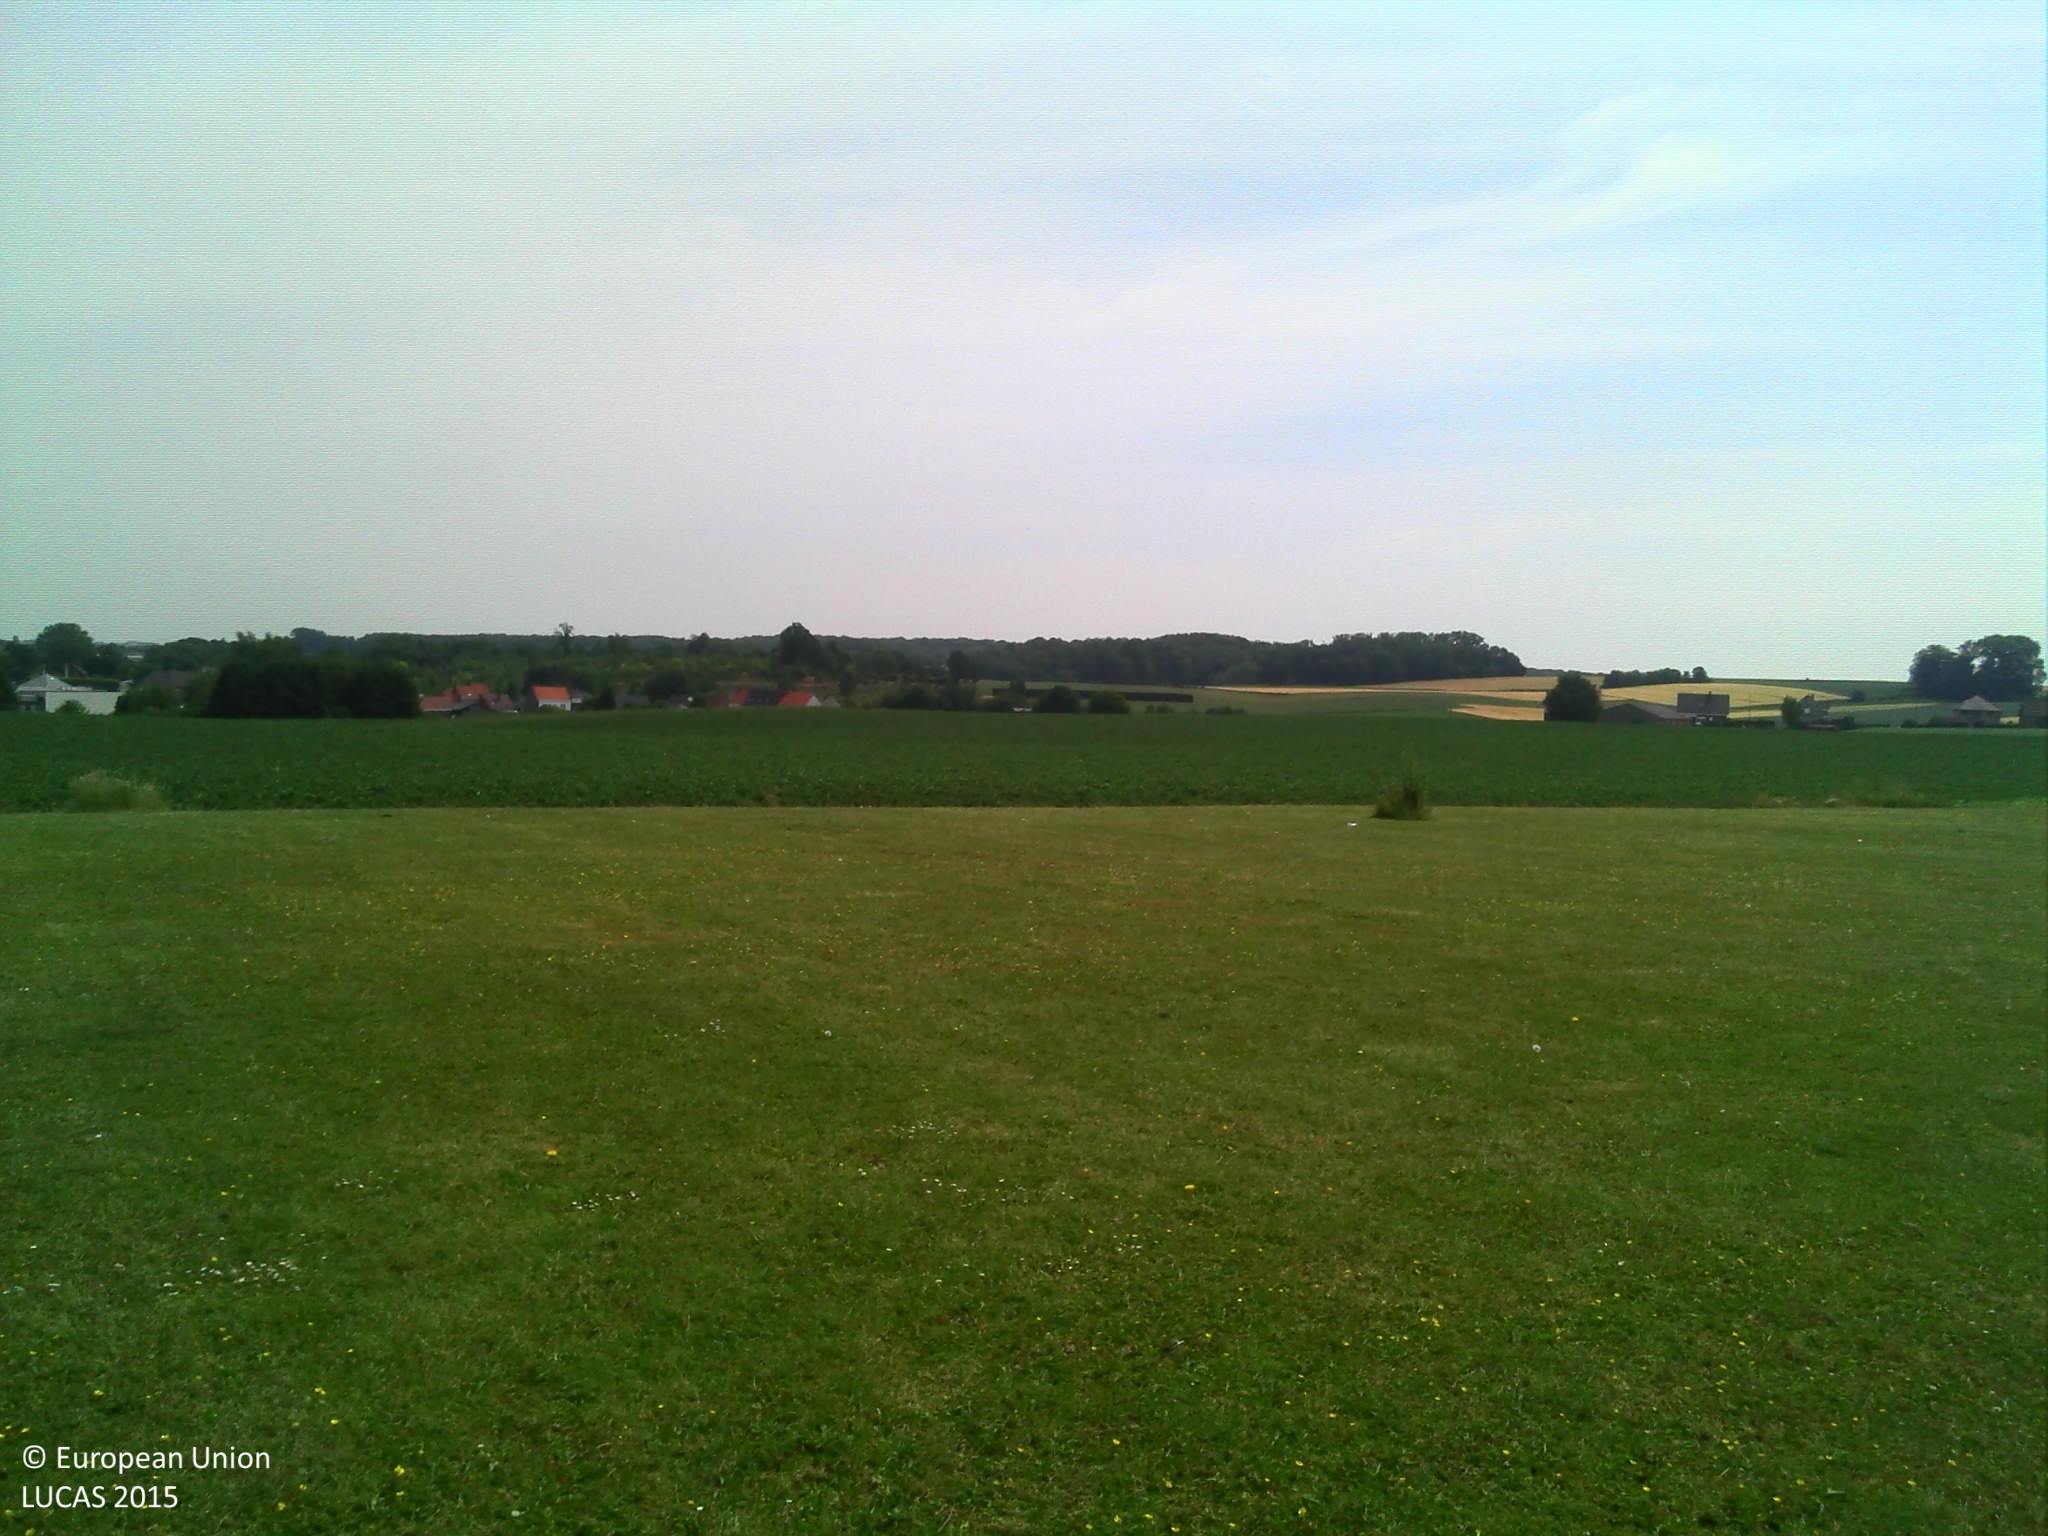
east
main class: Grassland
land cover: Grassland without tree/shrub cover
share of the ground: > 75 %
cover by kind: herbaceous plants 95 %, shrubs 5 %
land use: Sport
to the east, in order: Grassland without tree/shrub cover; Potatoes
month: June
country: BE
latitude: 50.8293
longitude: 4.5583
